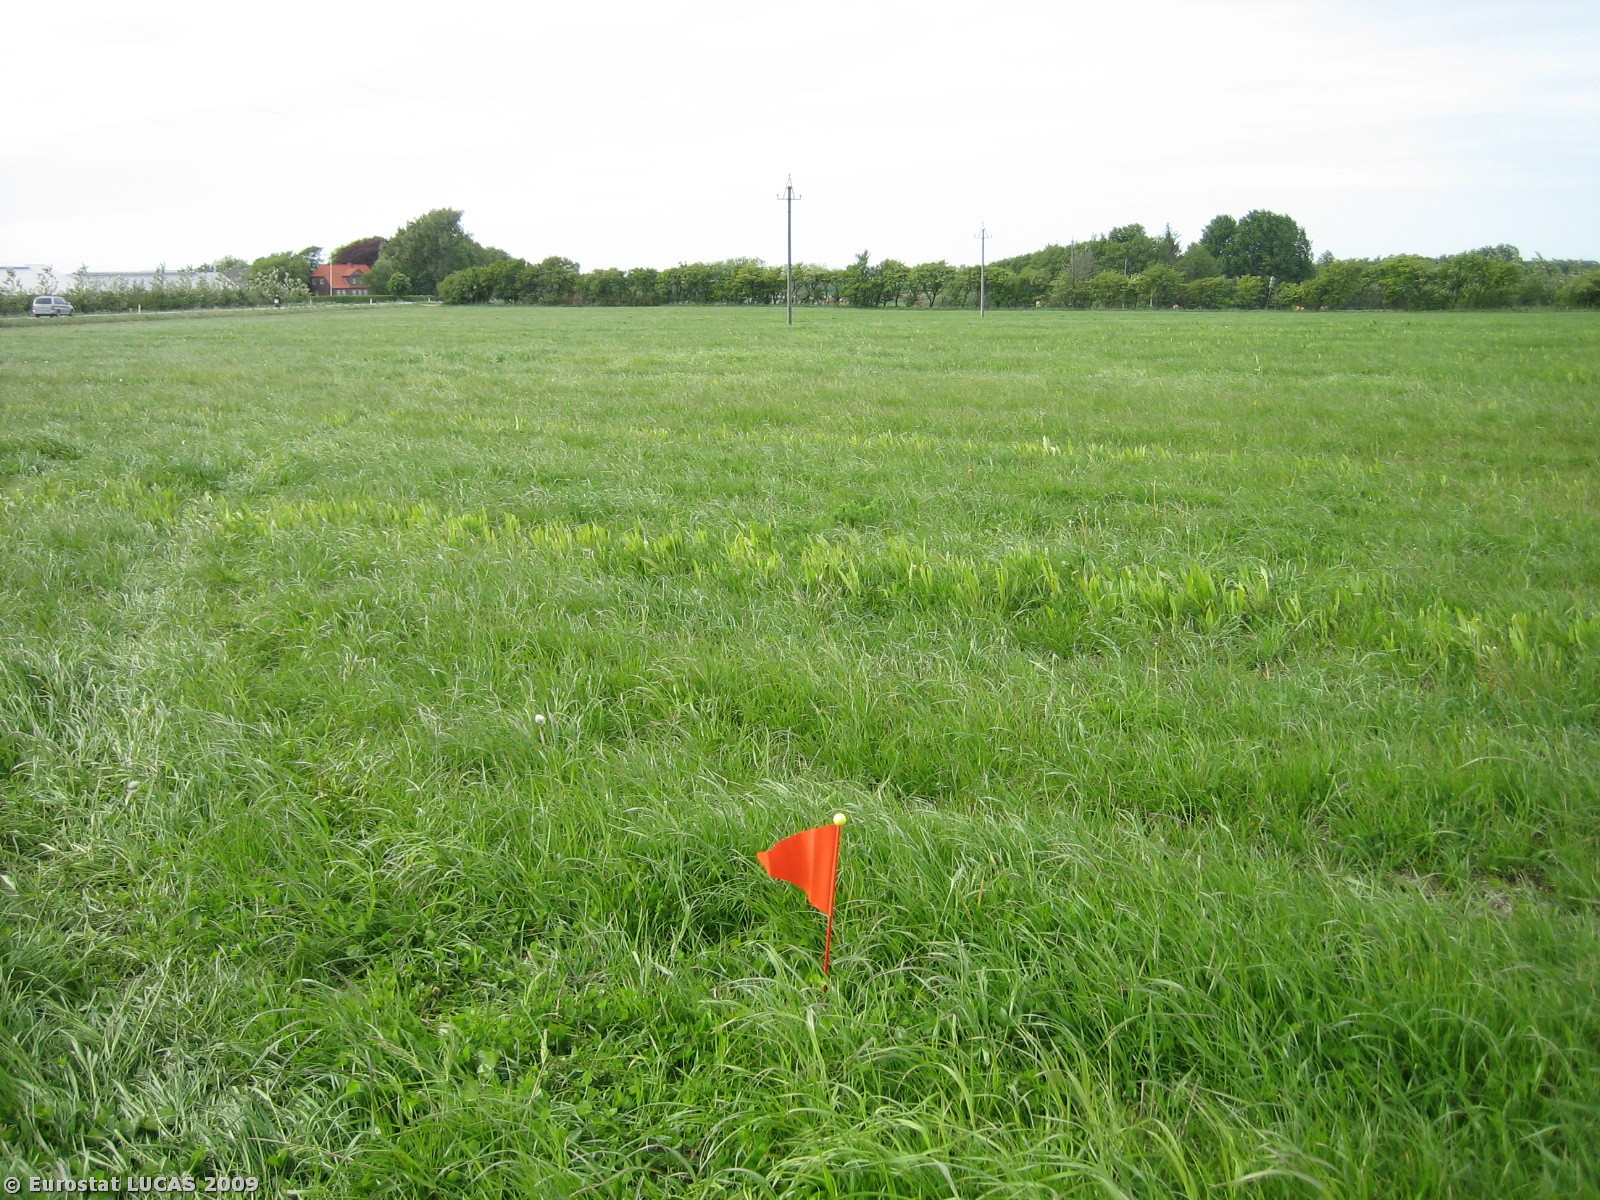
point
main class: Grassland
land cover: Grassland without tree/shrub cover
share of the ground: > 75 %
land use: Agriculture (excluding fallow land and kitchen gardens)
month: May
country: DK
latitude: 56.0341
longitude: 8.4128
